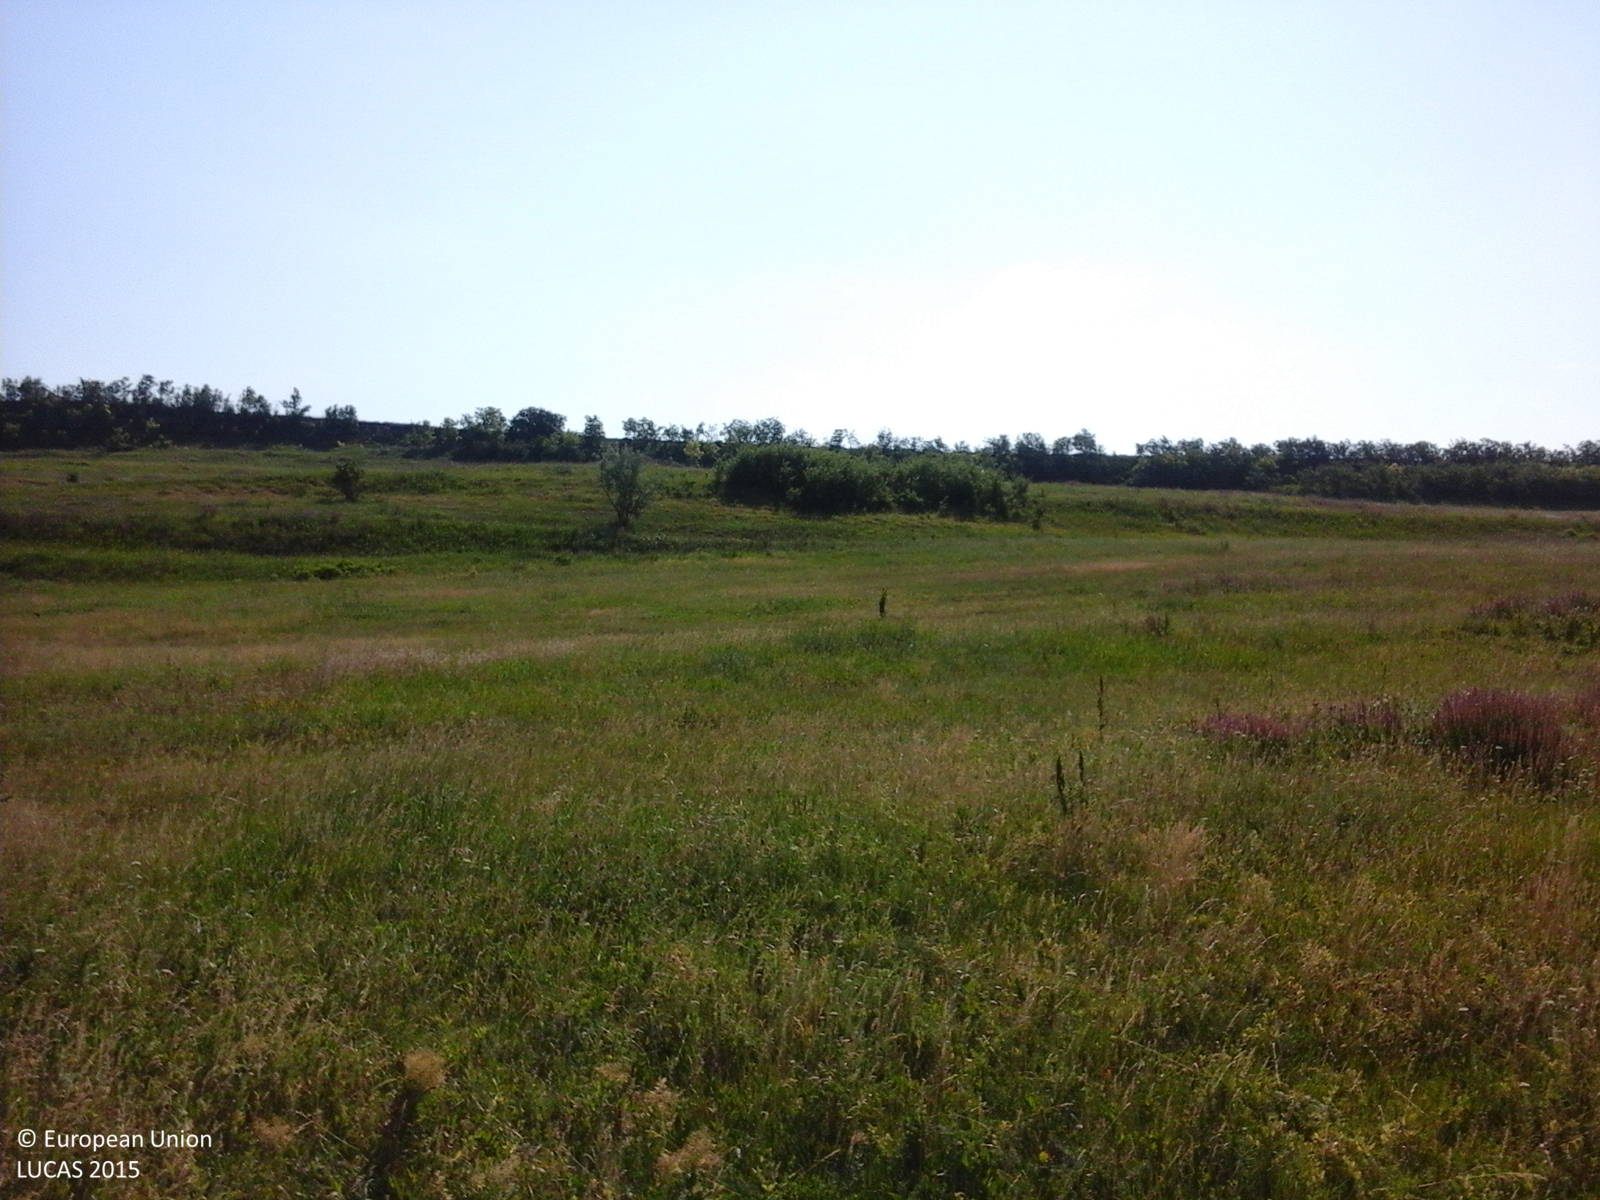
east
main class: Grassland
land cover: Grassland without tree/shrub cover
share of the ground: > 75 %
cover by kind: herbaceous plants 100 %
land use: Agriculture (excluding fallow land and kitchen gardens)
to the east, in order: Grassland without tree/shrub cover; Abandoned hedges; Grassland without tree/shrub cover; Grassland with sparse tree/shrub cover; Grassland without tree/shrub cover; Broadleaved woodland
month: June
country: RO
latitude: 47.9542
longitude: 26.6607
